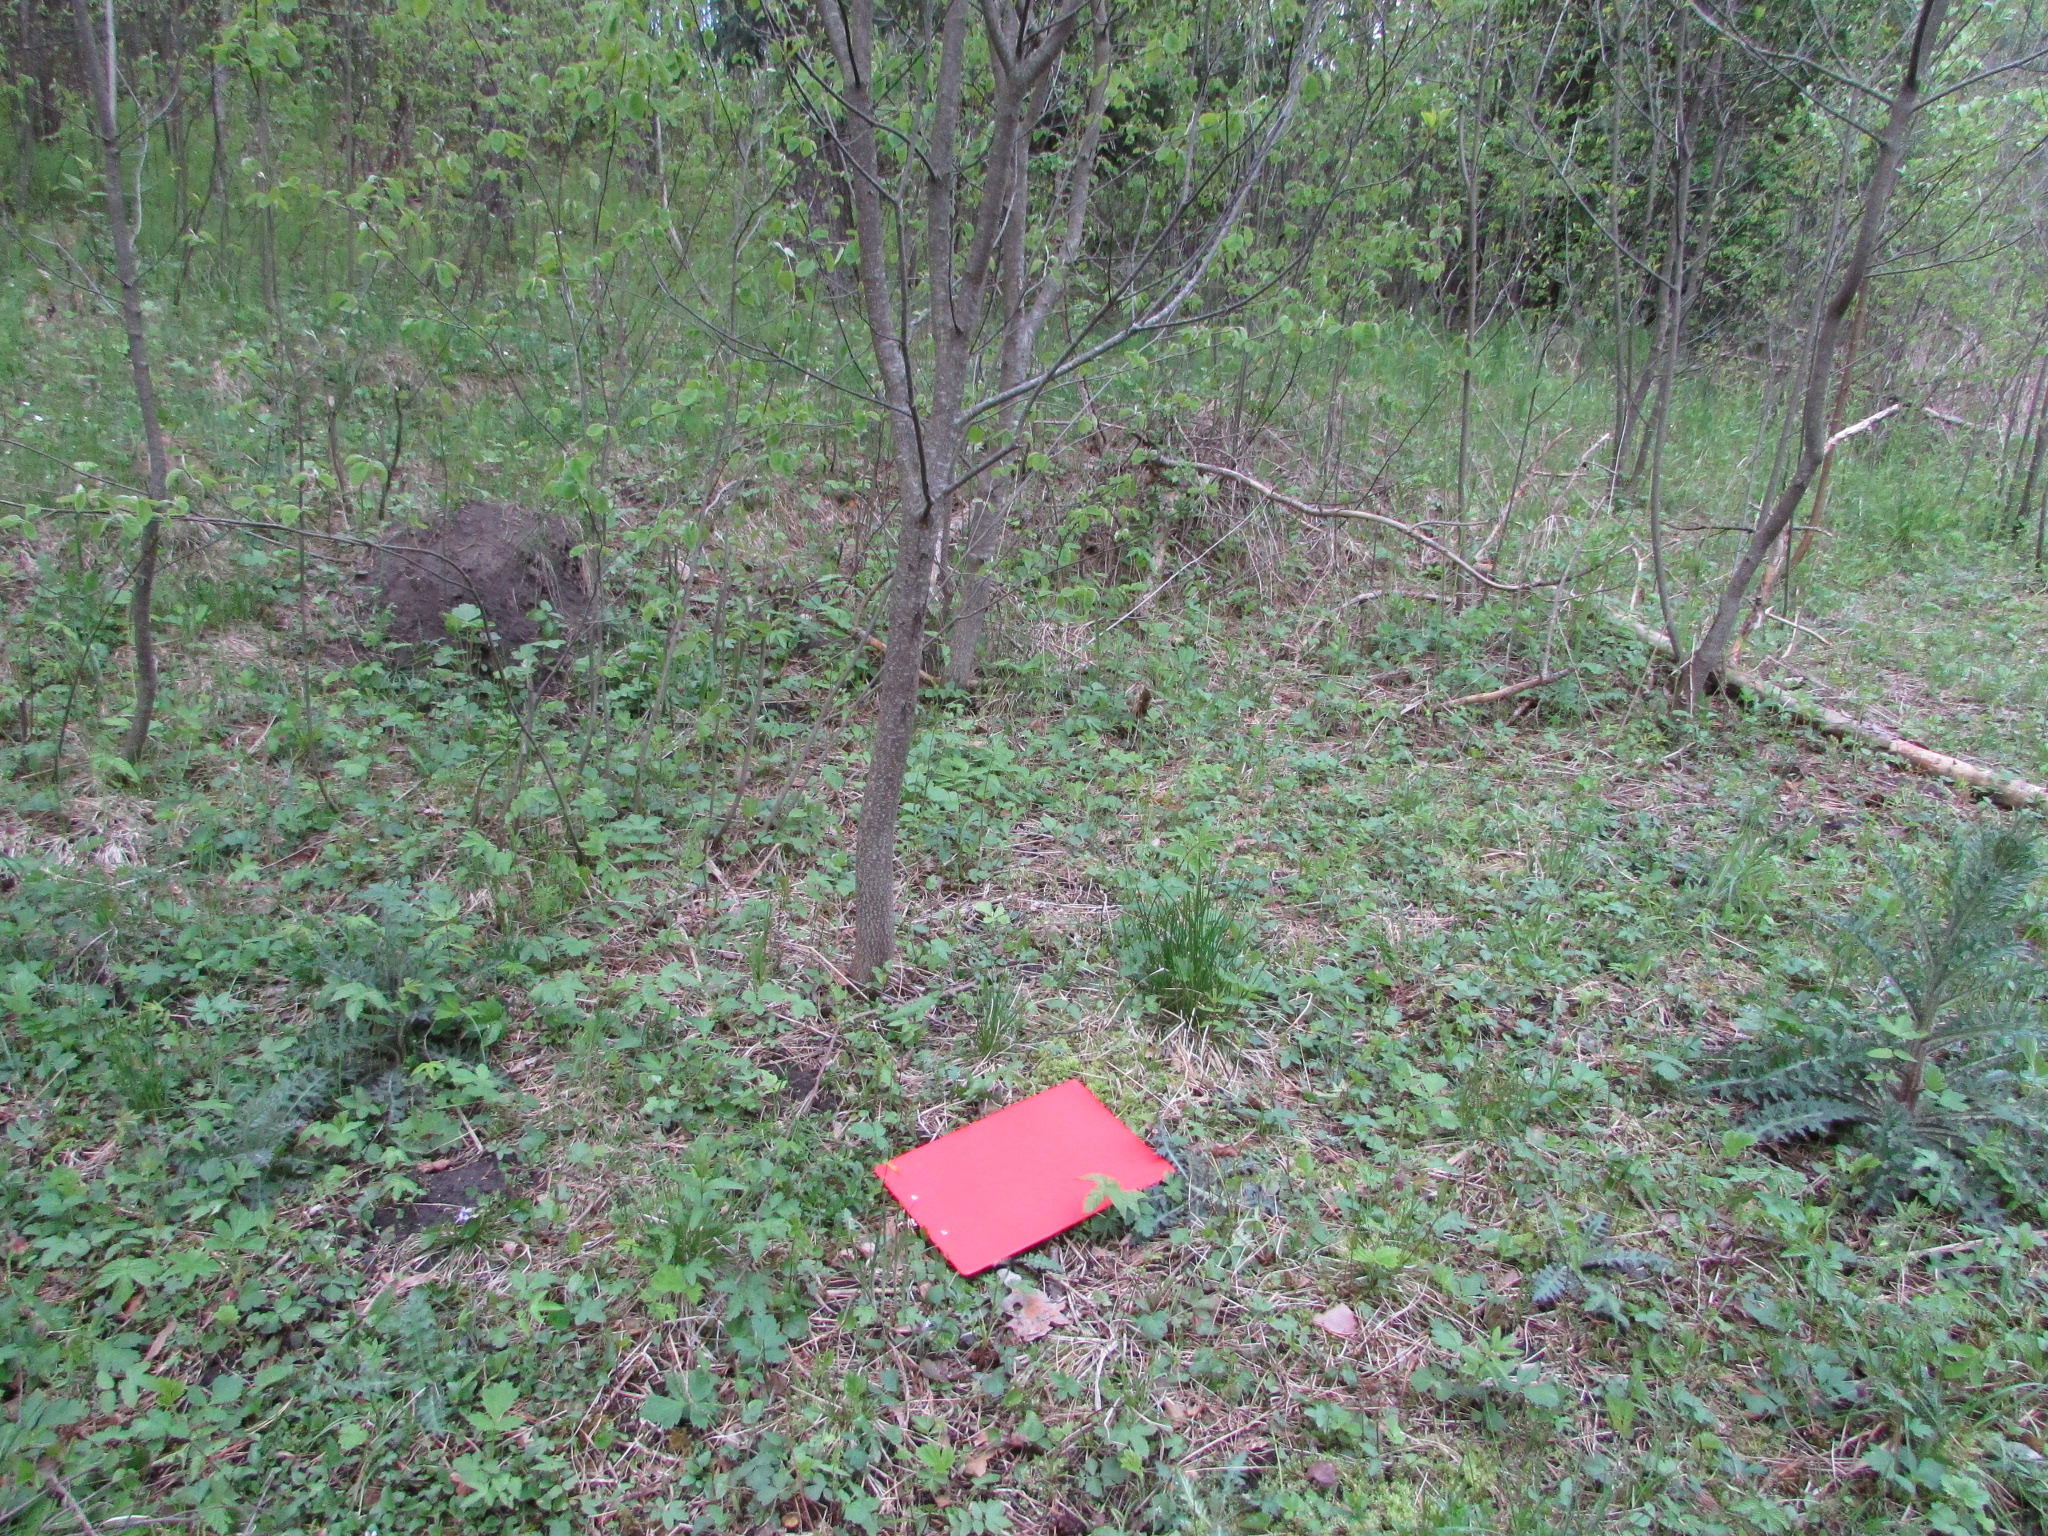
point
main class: Woodland
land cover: Pine dominated mixed woodland
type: hemiboreal forest and nemoral coniferous forest and mixed broadleaved-coniferous forest
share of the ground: > 75 %
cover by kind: coniferous forest trees 60 %, broadleaved forest trees 40 %
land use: Forestry
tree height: > 5 m
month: May
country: LV
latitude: 56.1402
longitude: 27.1809
